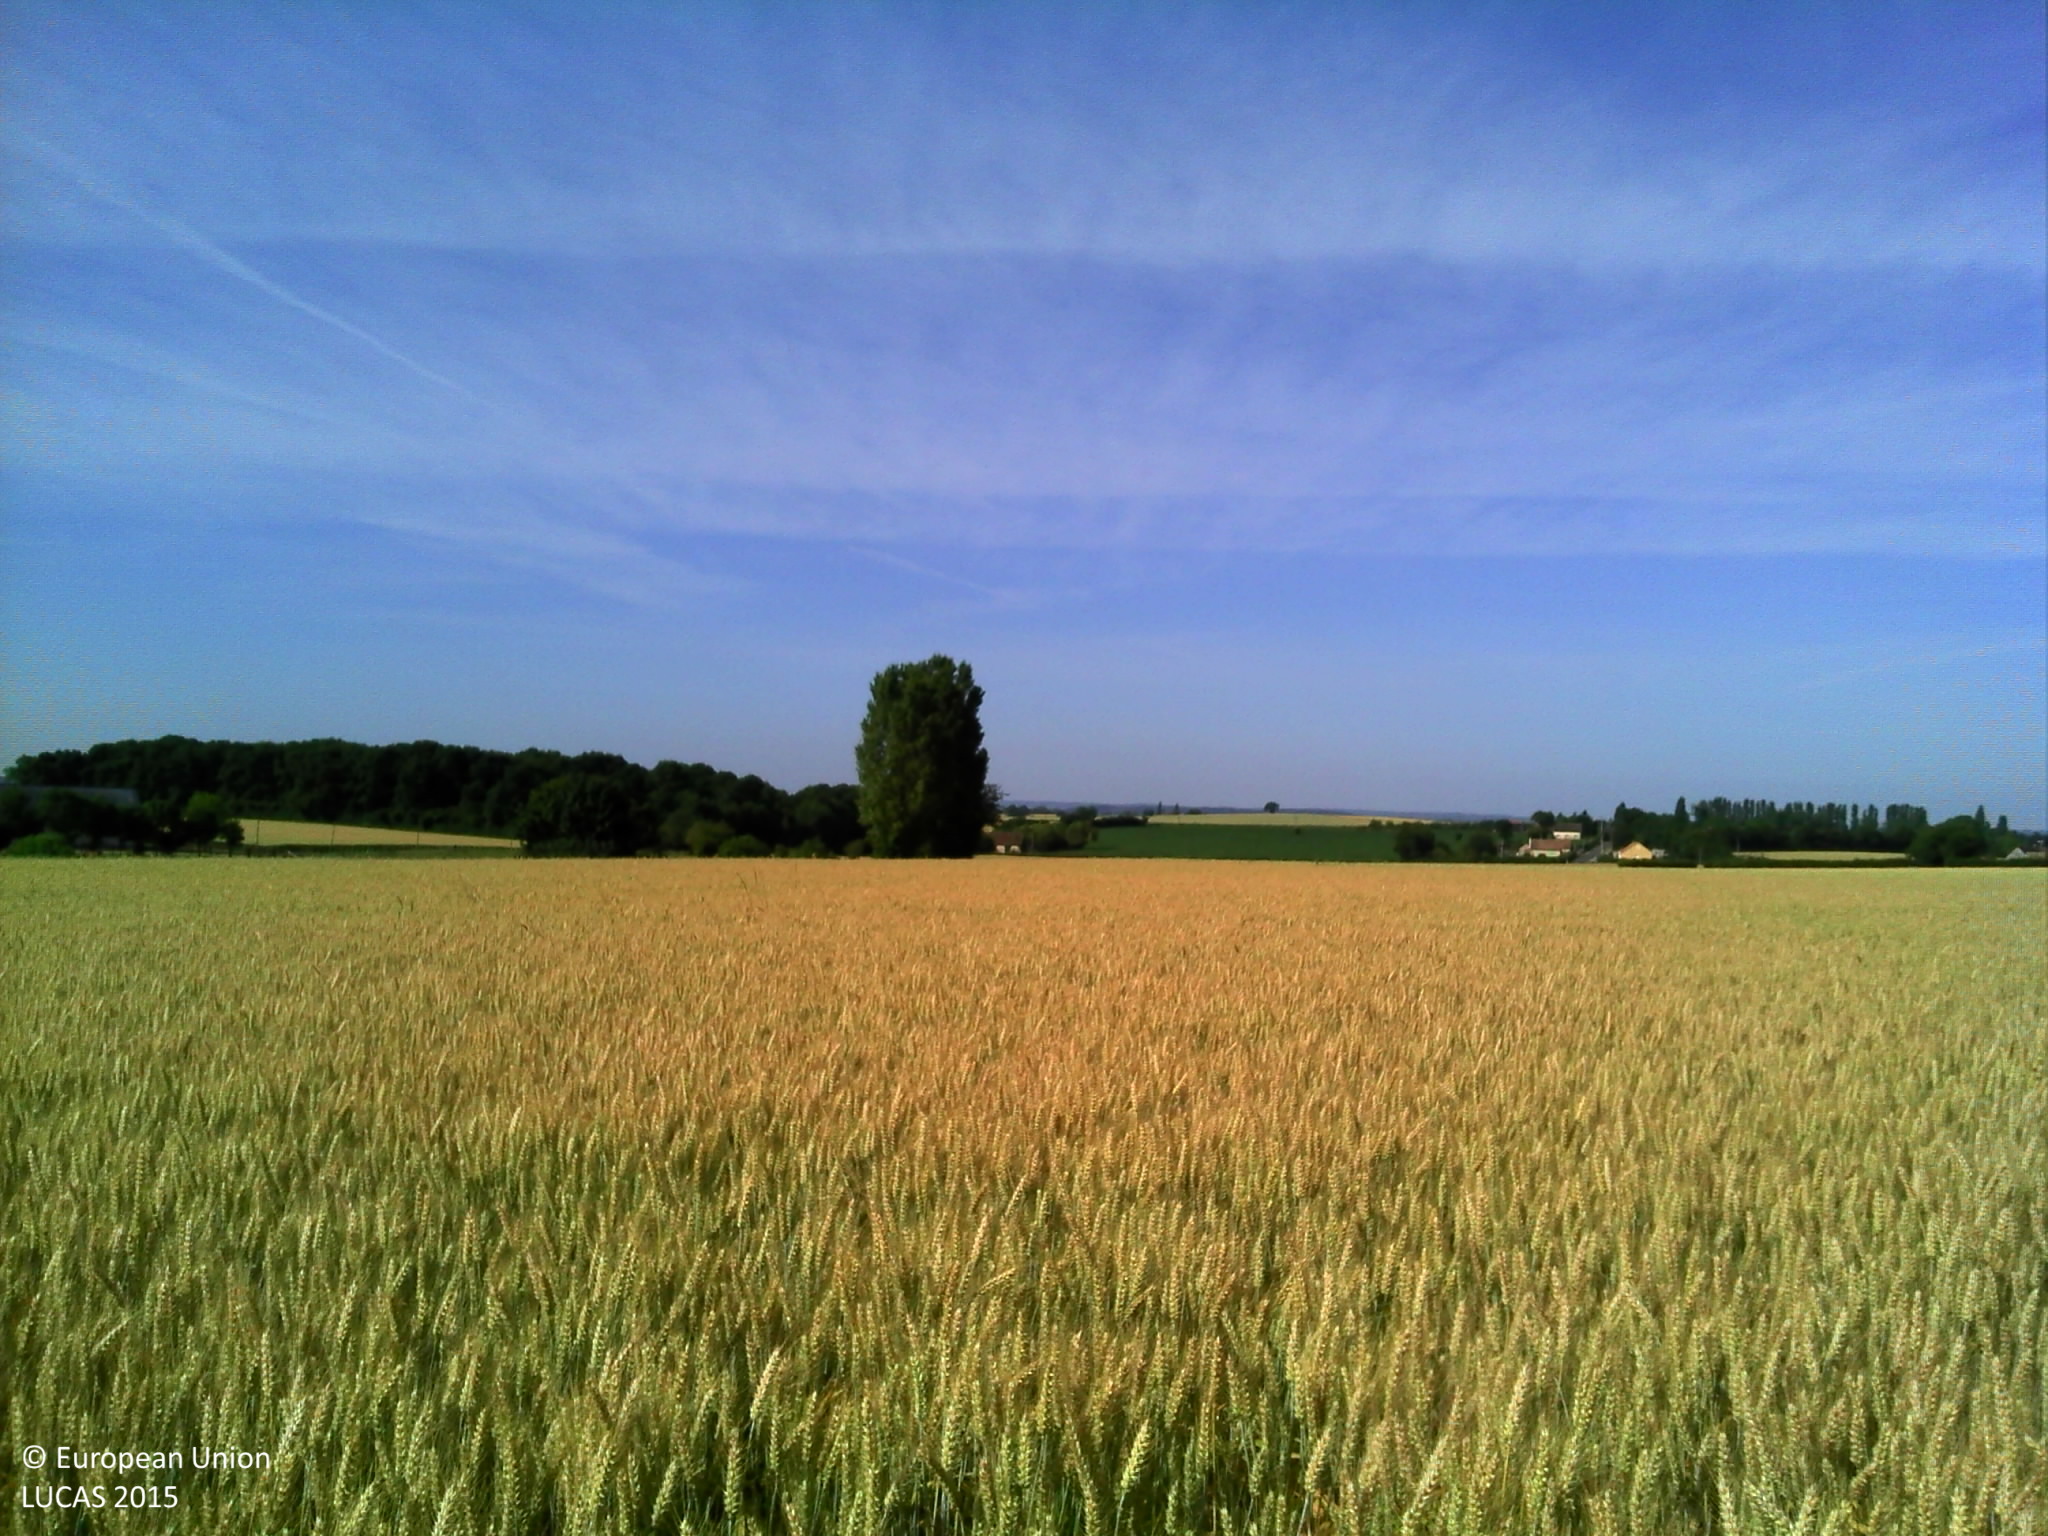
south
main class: Cropland
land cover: Triticale
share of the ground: > 75 %
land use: Agriculture (excluding fallow land and kitchen gardens)
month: June
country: FR
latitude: 48.2780
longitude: 0.2309
